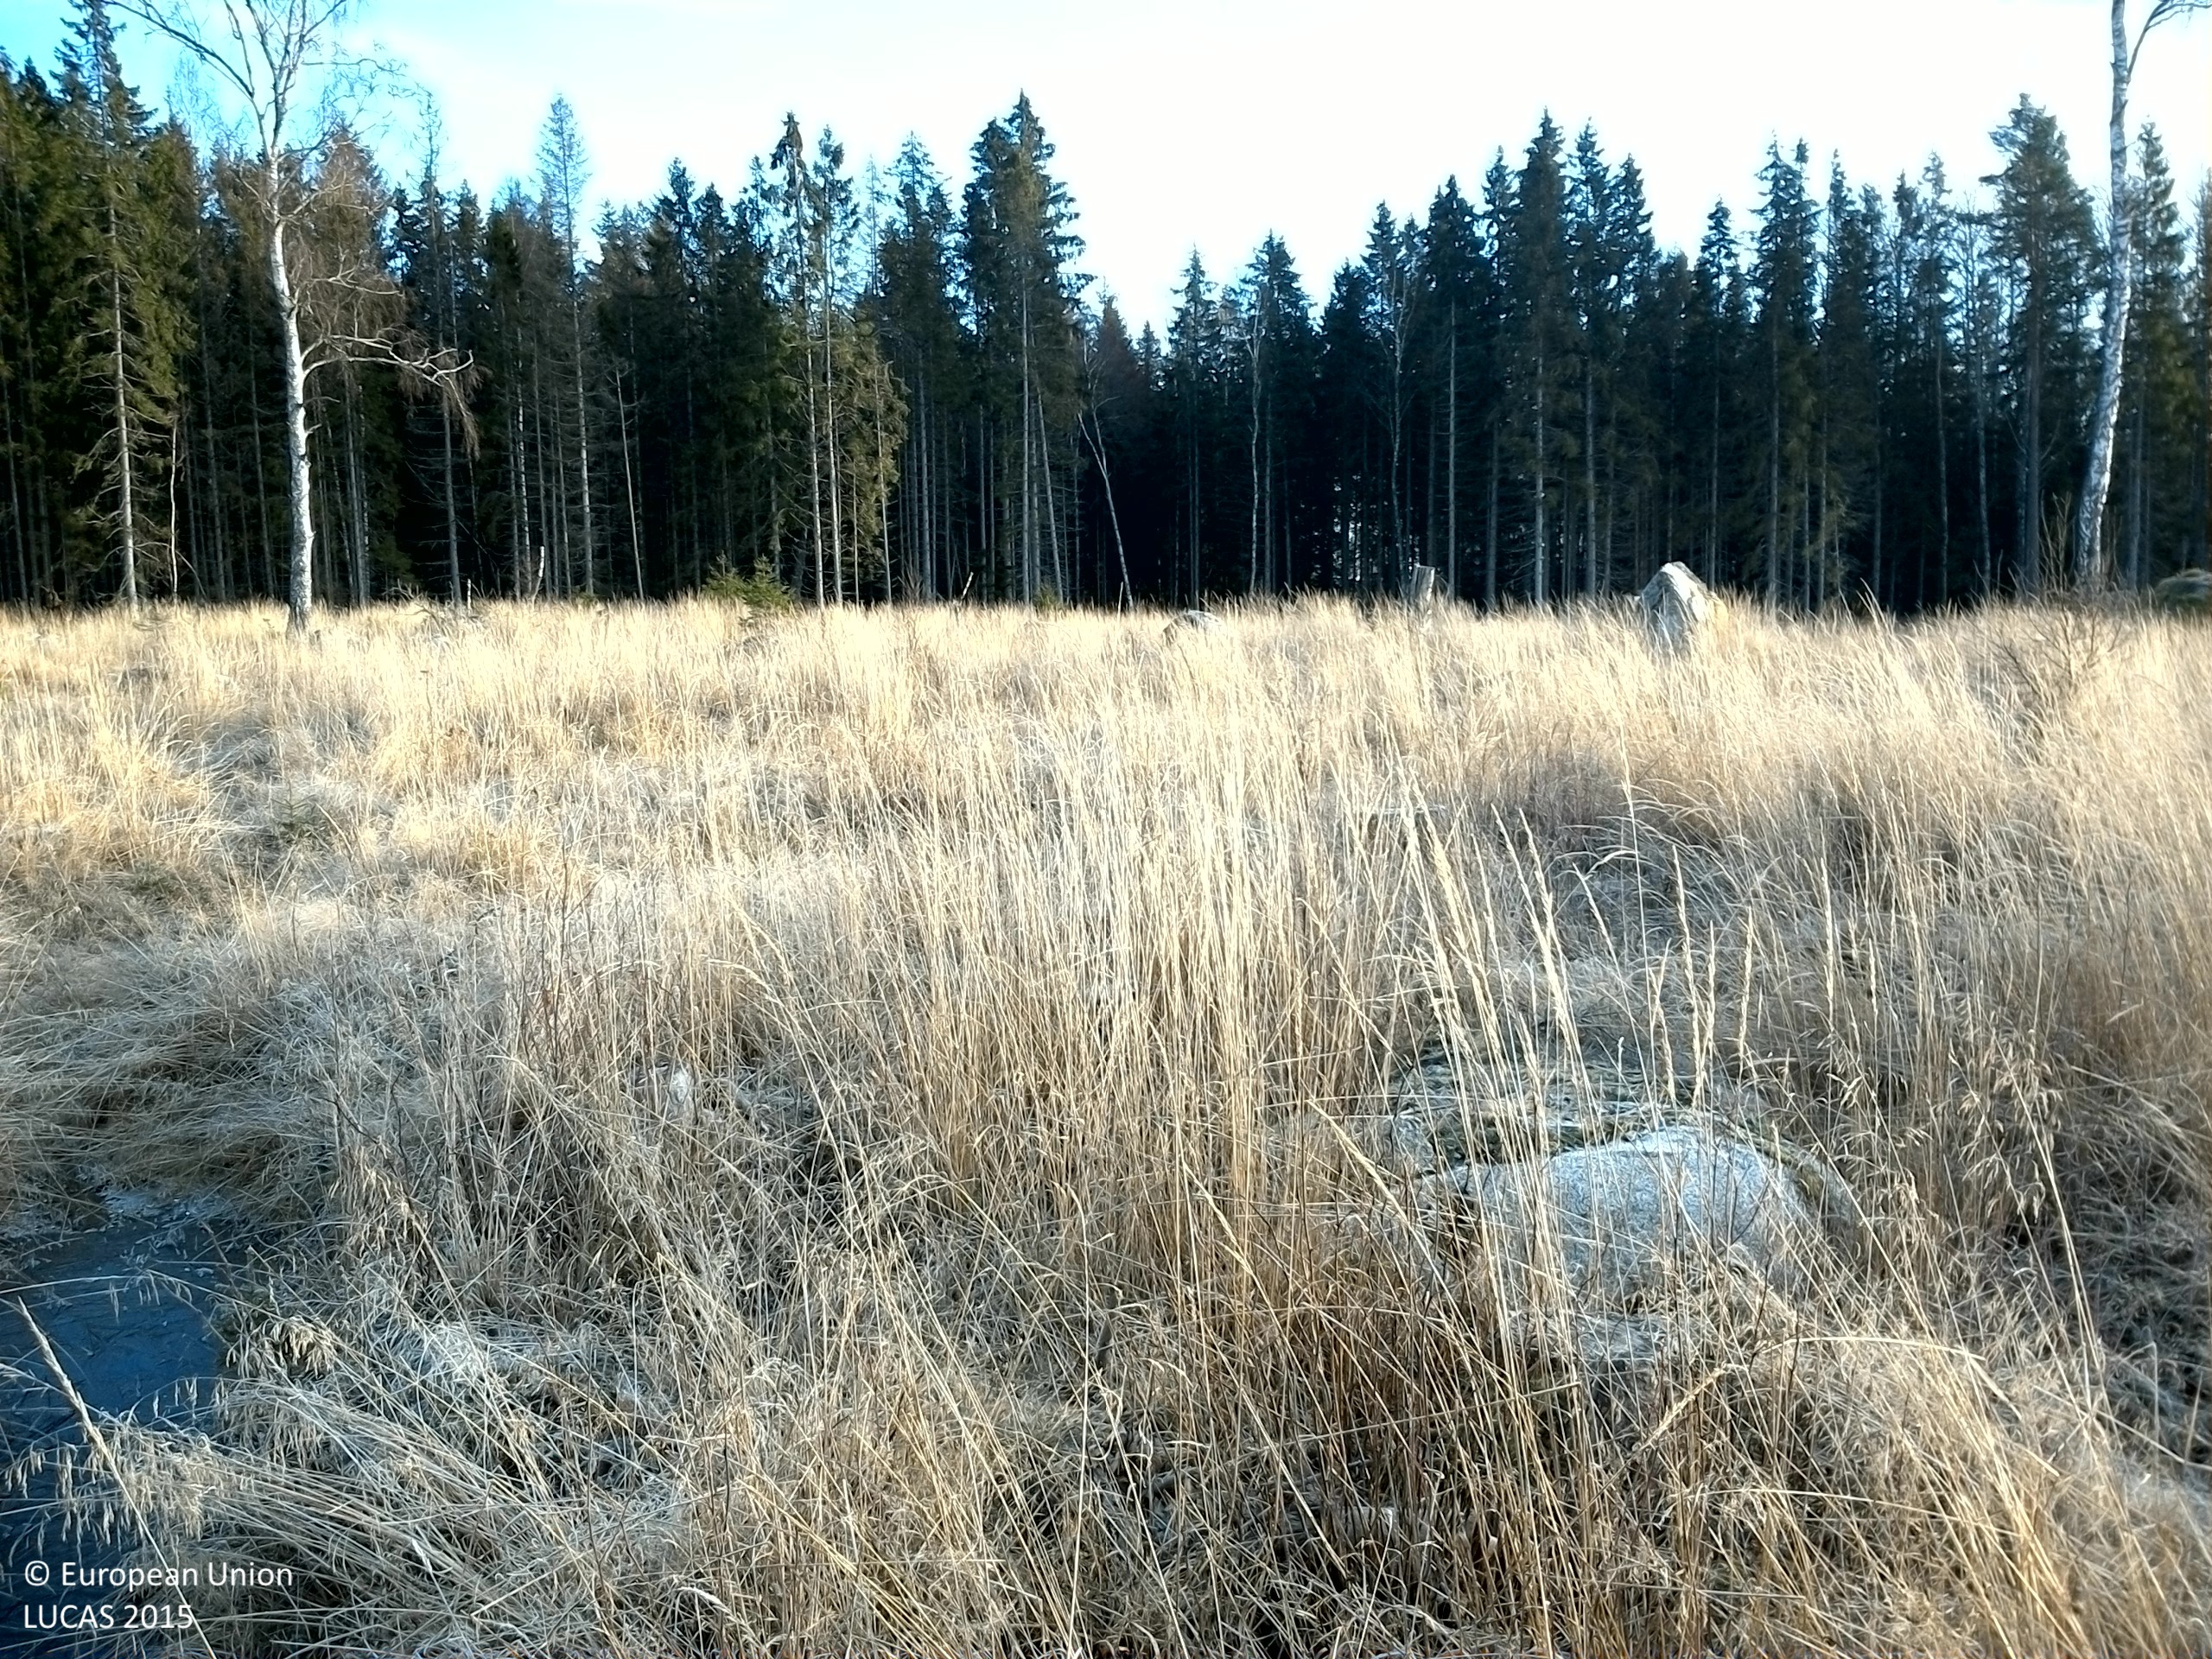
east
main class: Grassland
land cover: Grassland with sparse tree/shrub cover
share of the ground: > 75 %
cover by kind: herbaceous plants 85 %, coniferous forest trees 5 %, shrubs 5 %, consolidated bare surface 5 %
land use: Forestry
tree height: < 5 m
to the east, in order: Grassland with sparse tree/shrub cover; Spruce dominated coniferous woodland; Tracks; Spruce dominated mixed woodland; Spruce dominated coniferous woodland
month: December
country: SE
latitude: 59.7503
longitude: 16.7012
